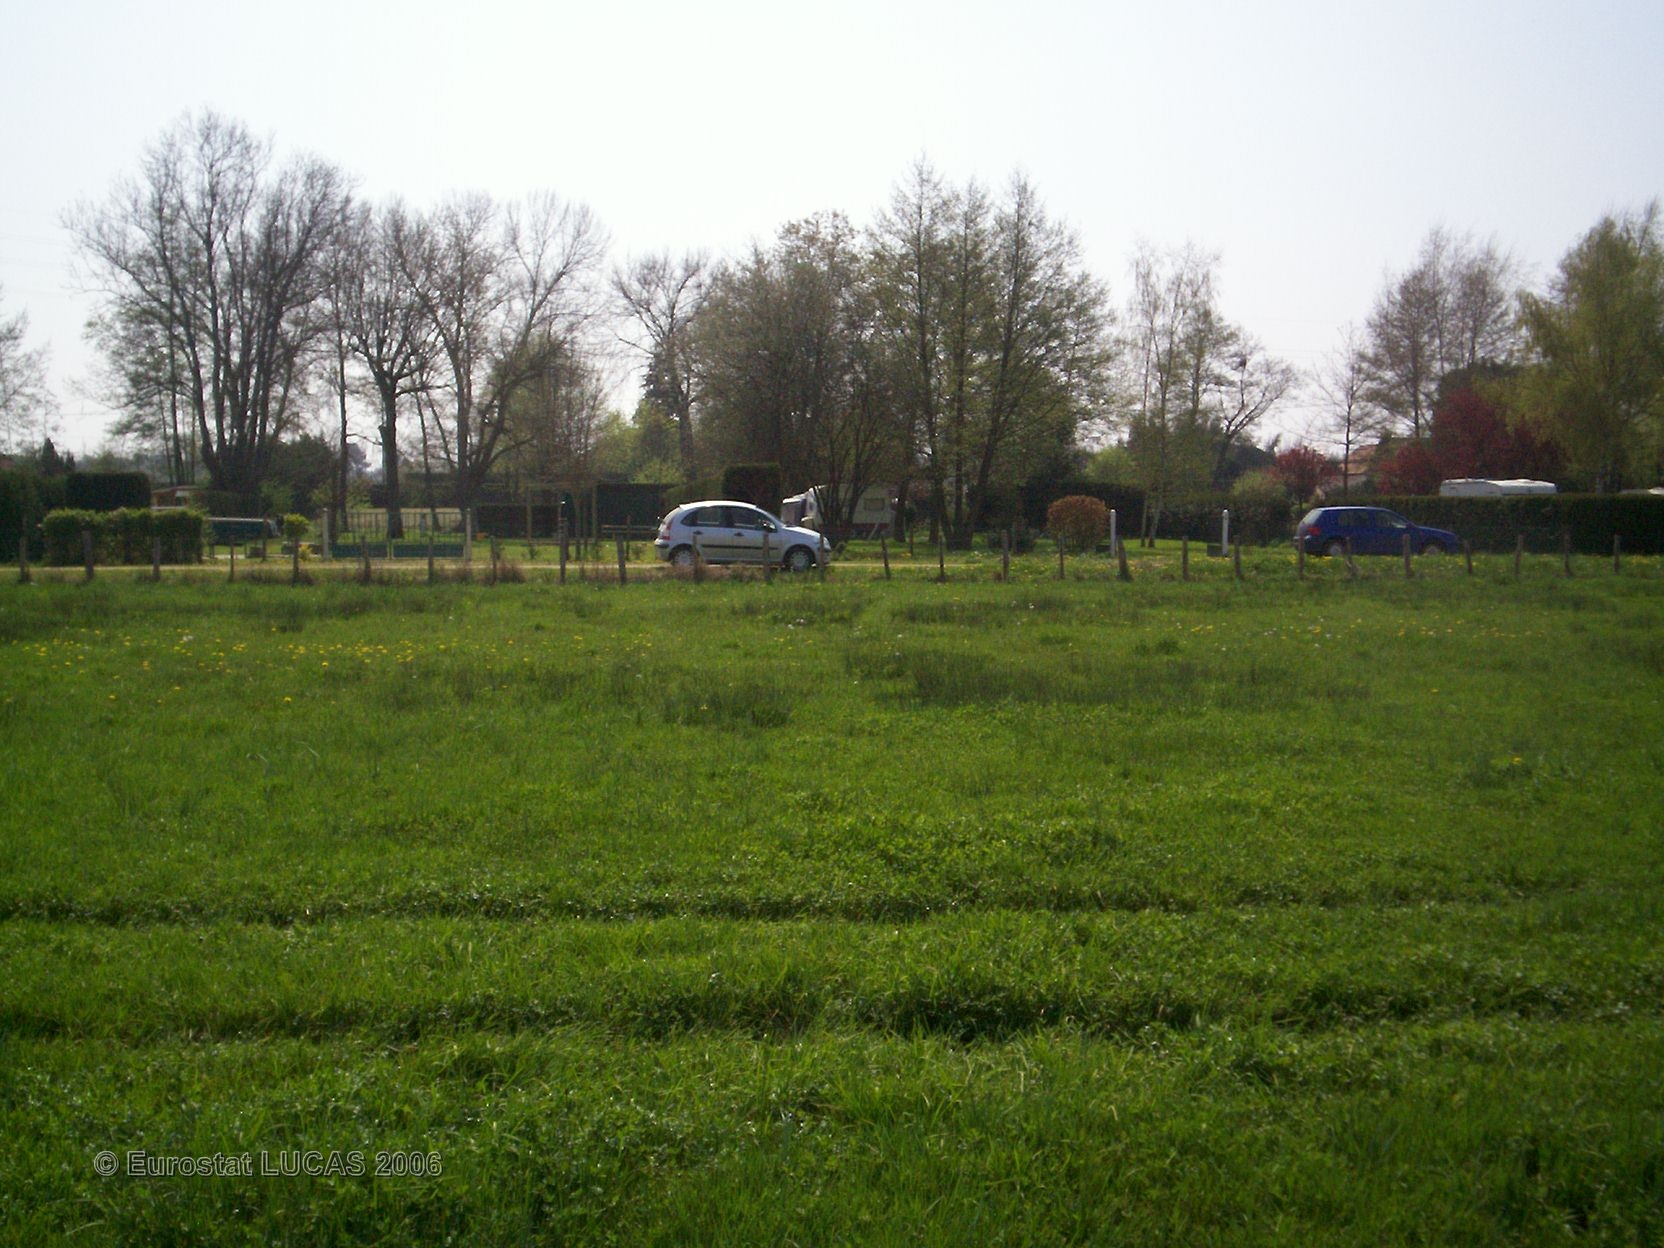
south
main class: Grassland
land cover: Grassland without tree/shrub cover
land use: Agriculture (excluding fallow land and kitchen gardens)
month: April
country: FR
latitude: 48.0380
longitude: 0.3857
